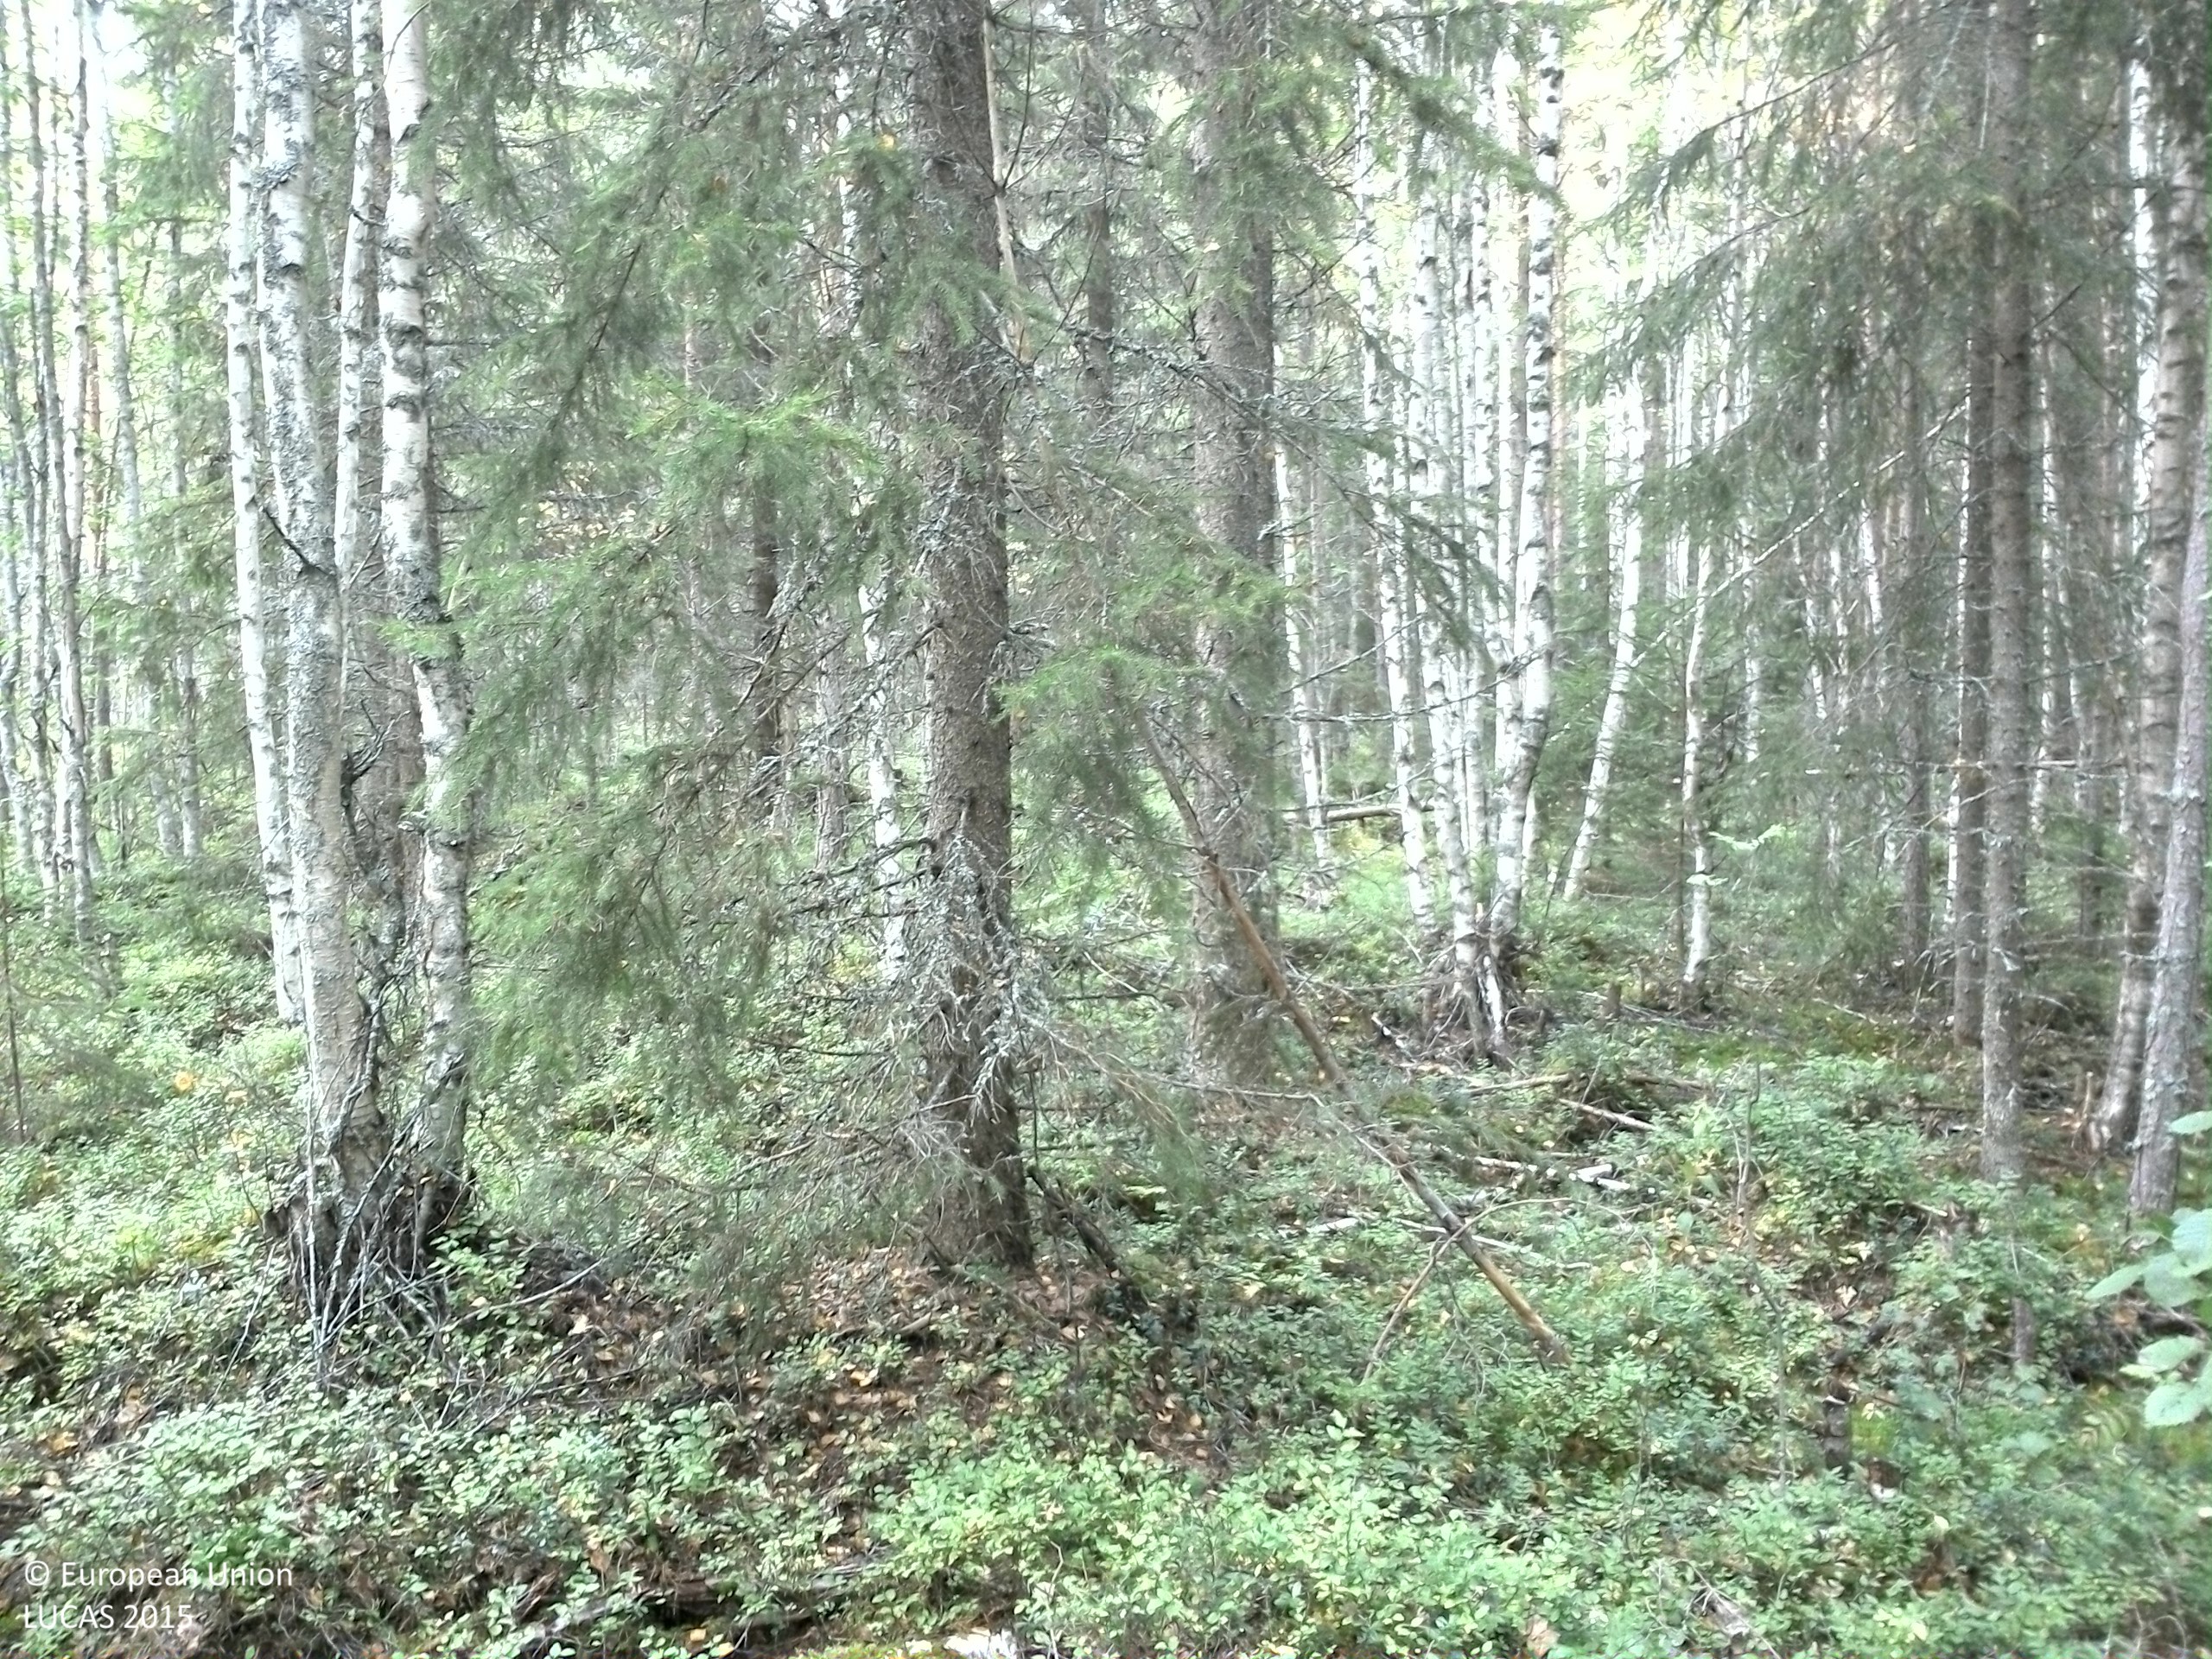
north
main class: Woodland
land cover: Spruce dominated mixed woodland
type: boreal forest
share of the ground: > 75 %
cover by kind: coniferous forest trees 50 %, broadleaved forest trees 25 %, shrubs 20 %, lichens and mosses 5 %
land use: Forestry
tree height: > 5 m
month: September
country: SE
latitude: 61.2684
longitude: 15.4116
